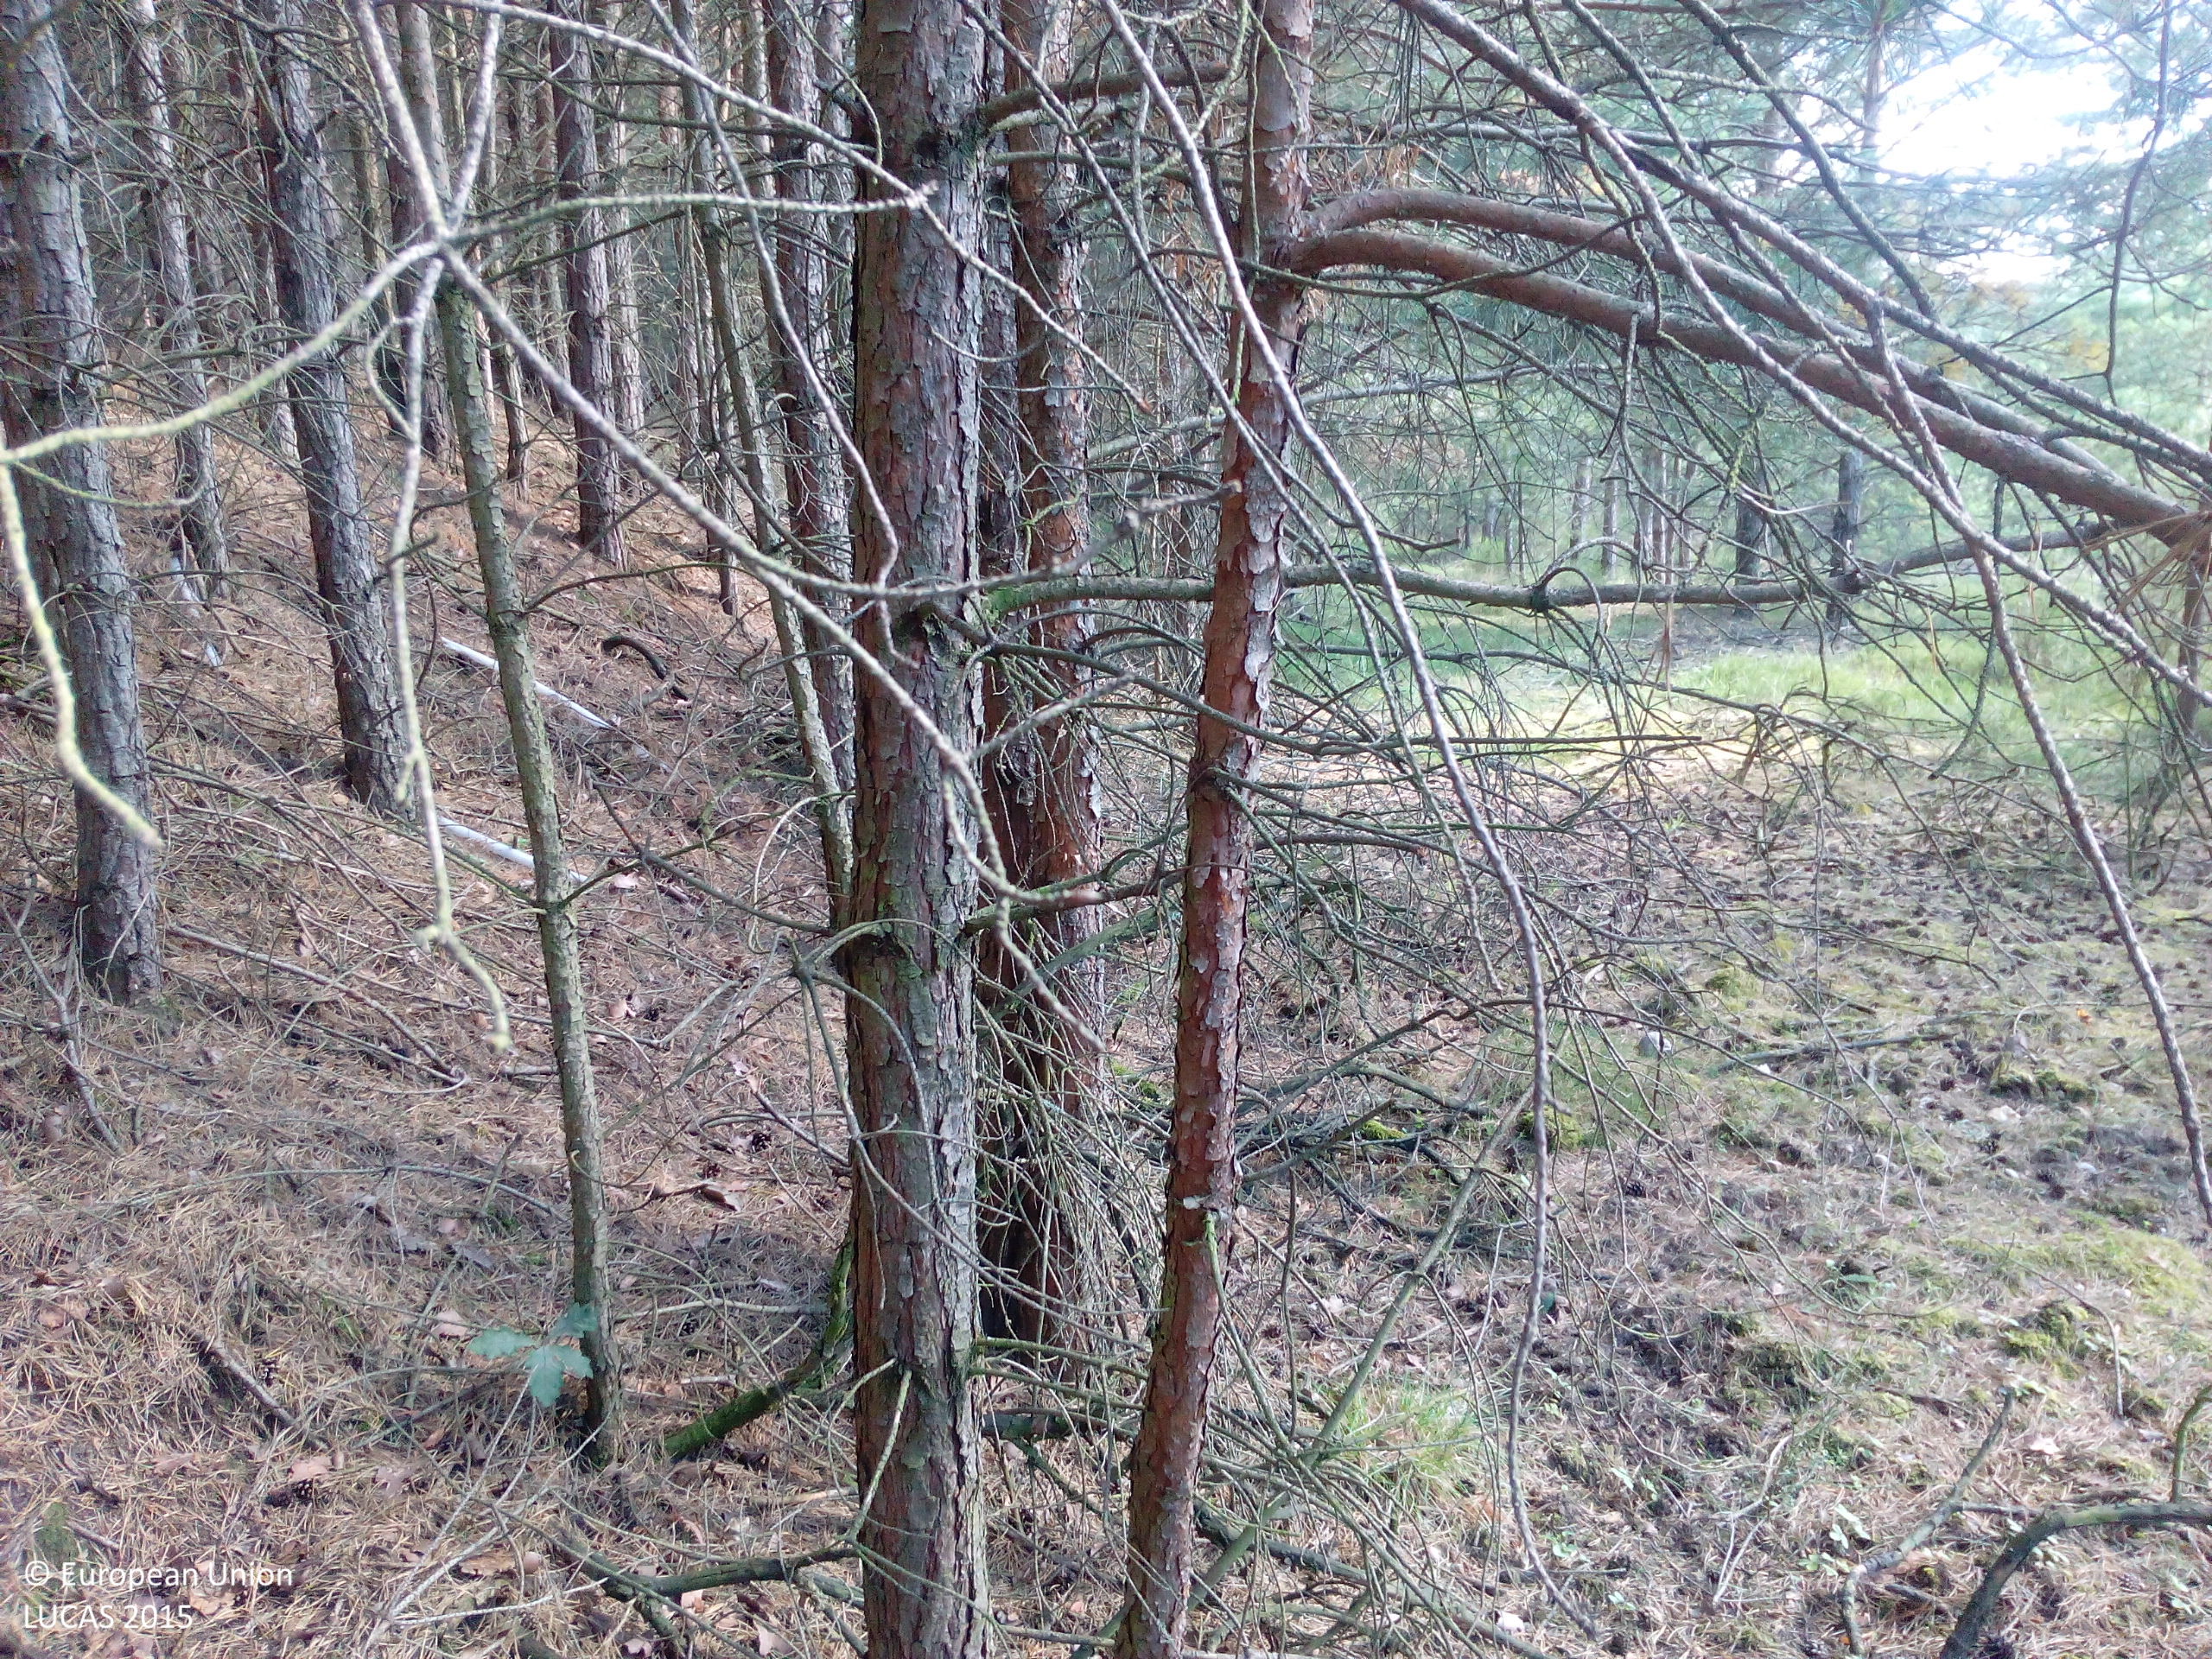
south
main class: Woodland
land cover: Pine dominated coniferous woodland
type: hemiboreal forest and nemoral coniferous forest and mixed broadleaved-coniferous forest
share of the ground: > 75 %
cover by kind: coniferous forest trees 100 %
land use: Forestry
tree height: > 5 m
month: July
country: DE
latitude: 51.6072
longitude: 14.0297
